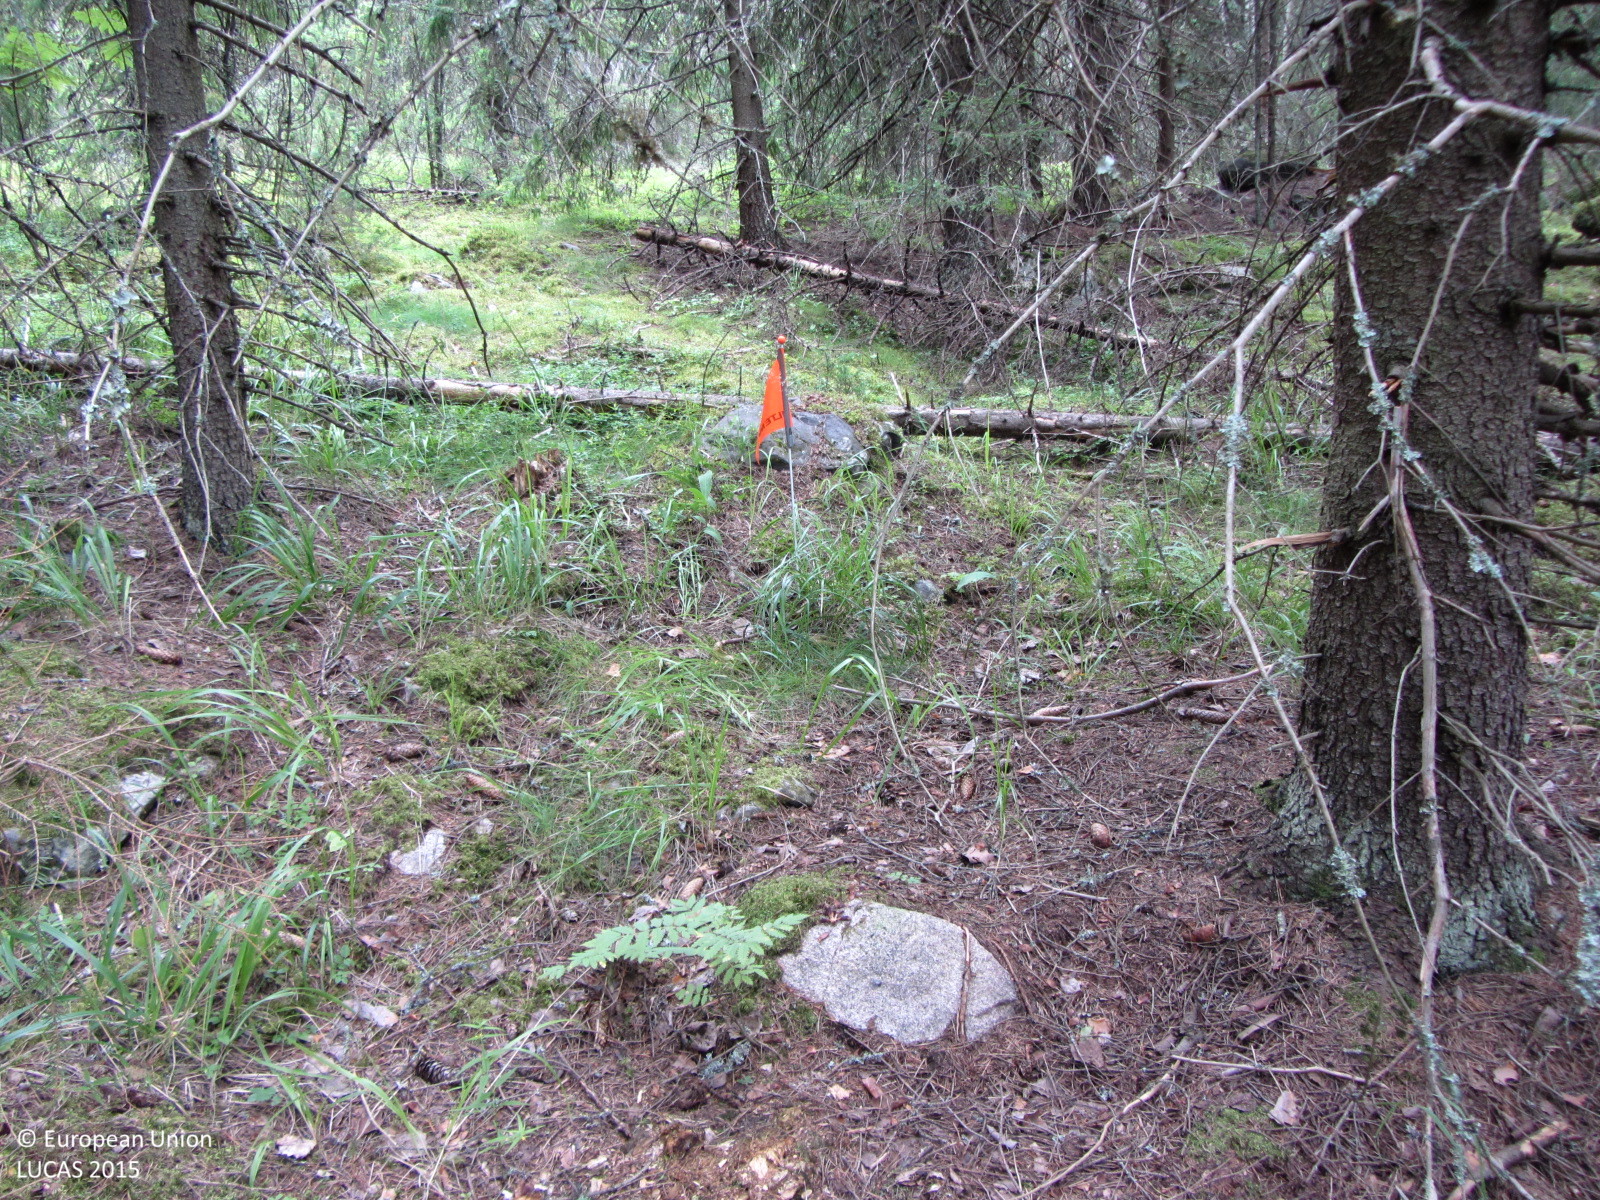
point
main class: Woodland
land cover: Spruce dominated coniferous woodland
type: boreal forest
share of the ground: > 75 %
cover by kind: coniferous forest trees 65 %, broadleaved forest trees 10 %, shrubs 10 %, herbaceous plants 5 %, lichens and mosses 5 %, consolidated bare surface 5 %
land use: Forestry
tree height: > 5 m
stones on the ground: 10 - 25 %
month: July
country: FI
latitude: 60.6341
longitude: 24.5297
